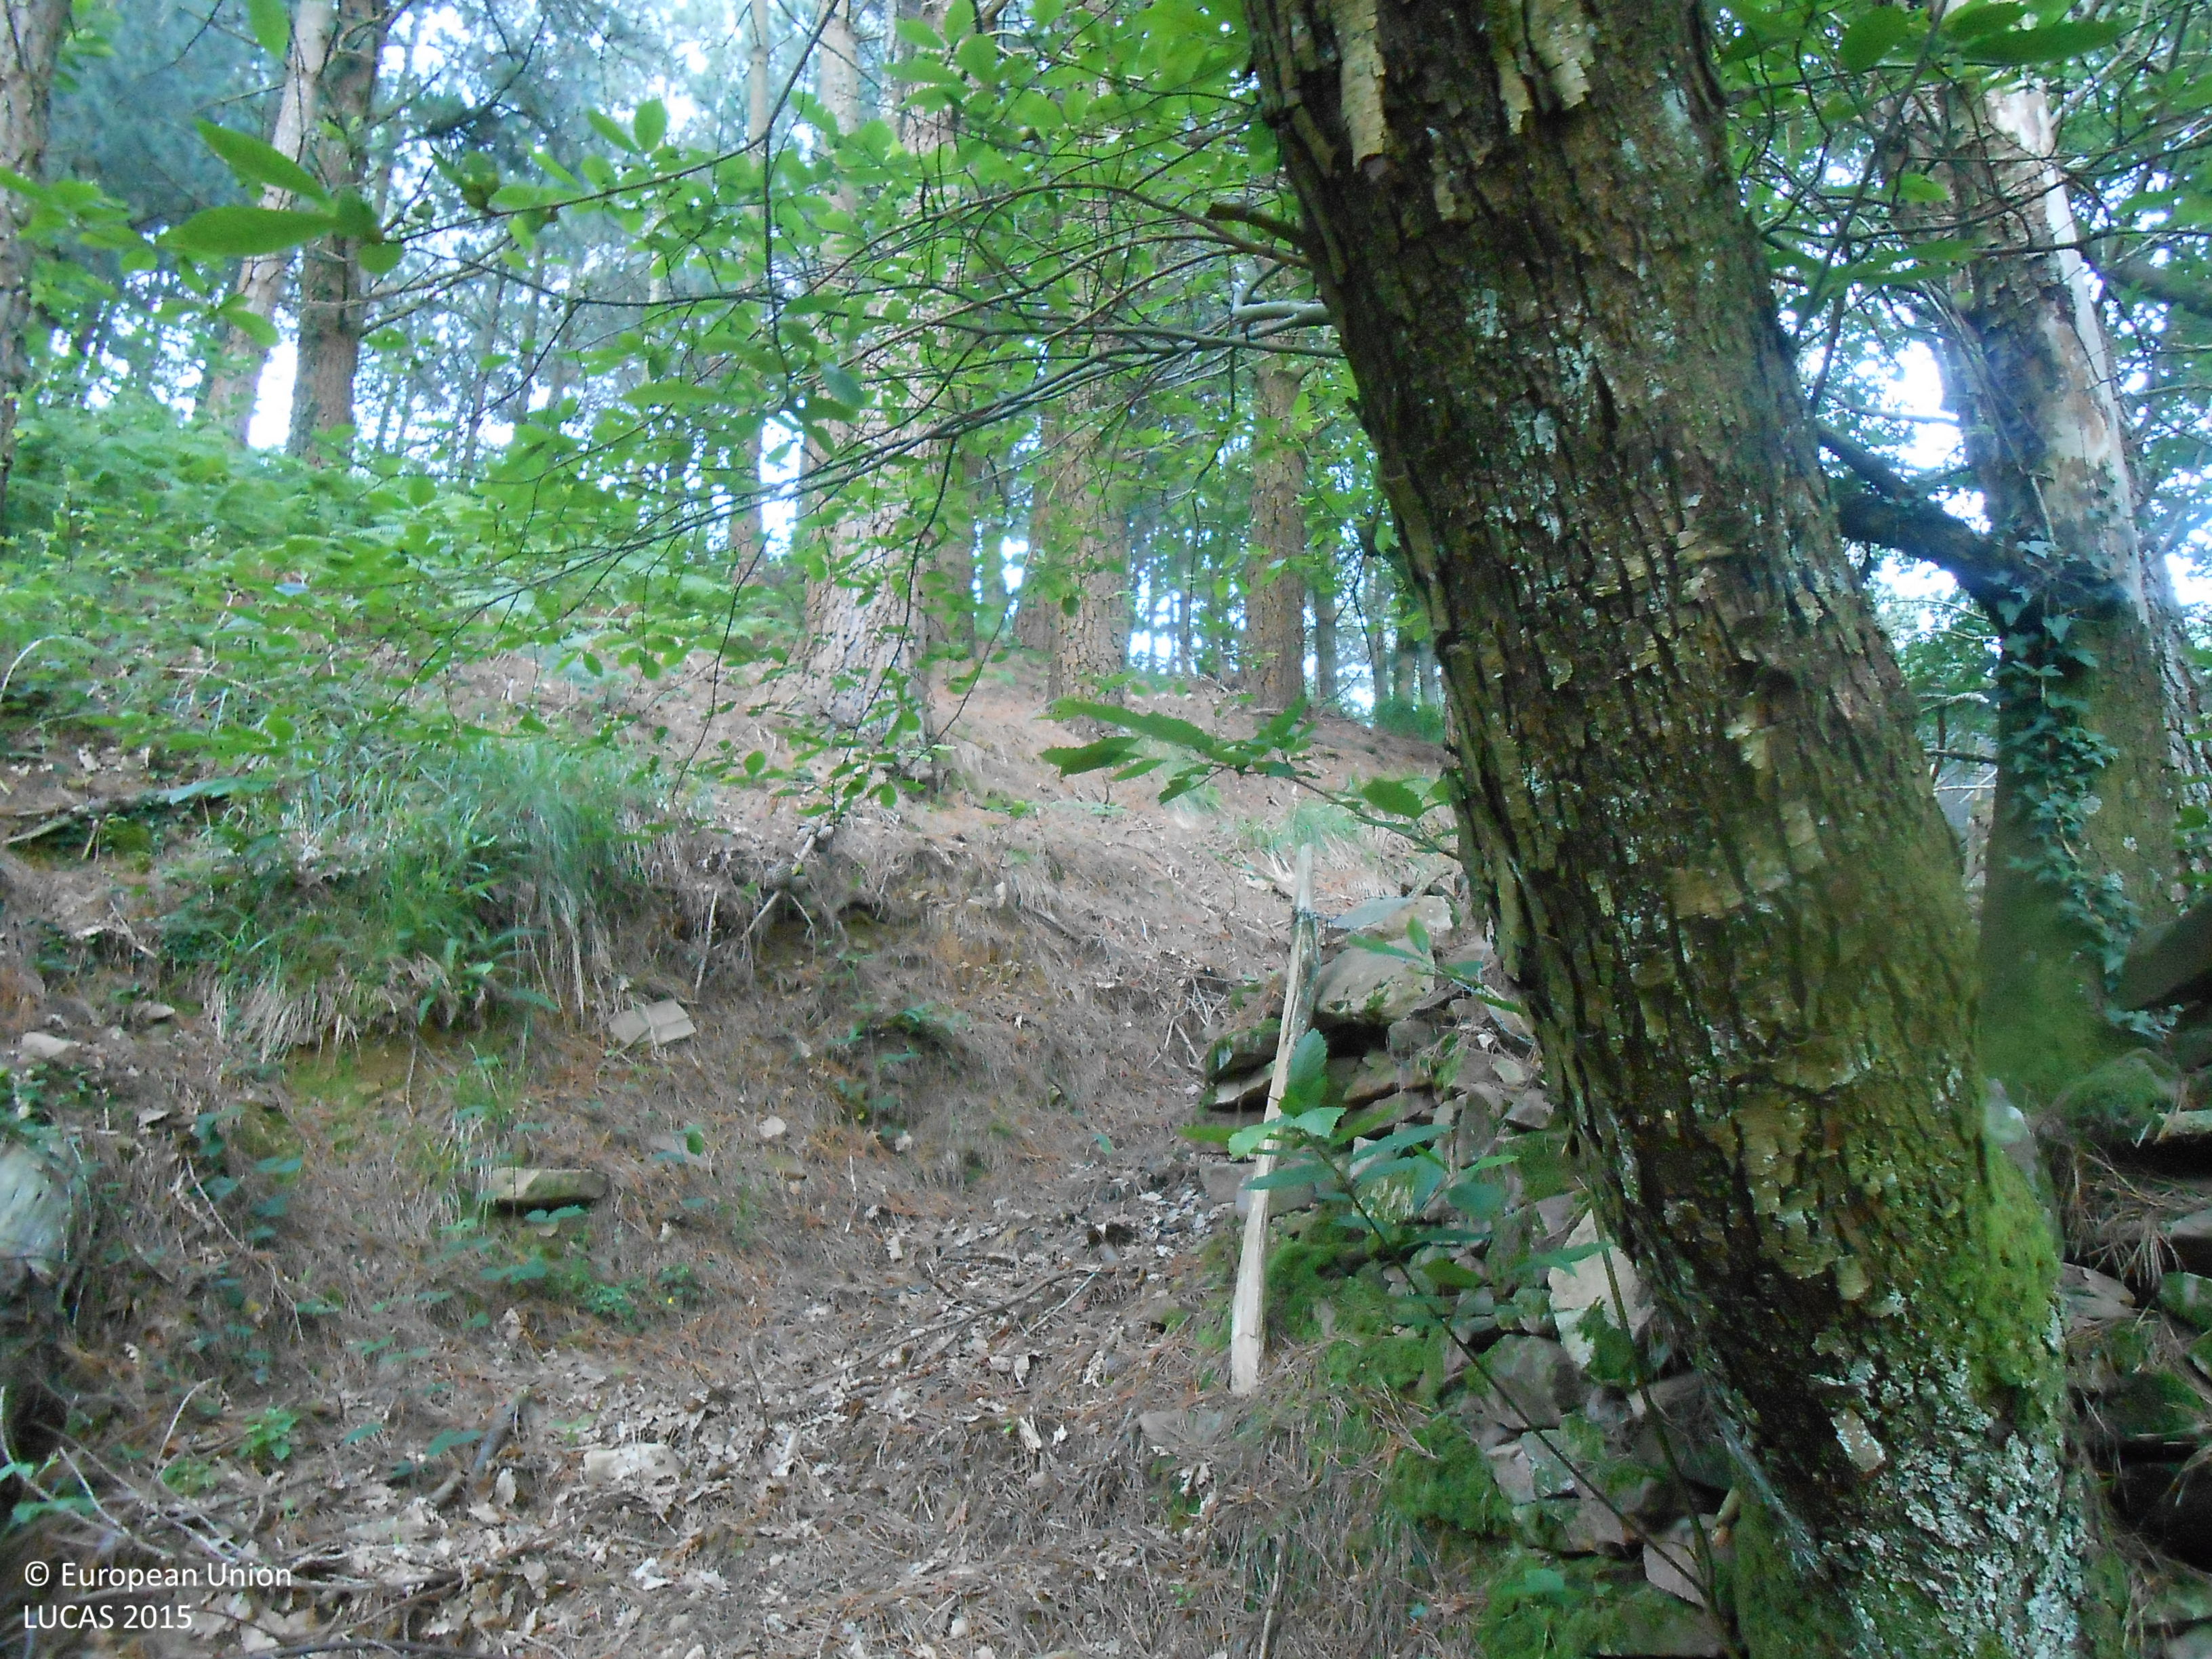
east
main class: Woodland
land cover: Pine dominated mixed woodland
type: hemiboreal forest and nemoral coniferous forest and mixed broadleaved-coniferous forest
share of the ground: > 75 %
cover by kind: coniferous forest trees 75 %, broadleaved forest trees 25 %
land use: Forestry
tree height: > 5 m
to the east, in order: Pine dominated mixed woodland; Tracks; Broadleaved woodland; Fences; Dry stone walls; Pine dominated coniferous woodland; Dry stone walls; Pine dominated coniferous woodland
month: June
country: ES
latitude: 43.0890
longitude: -1.8242
